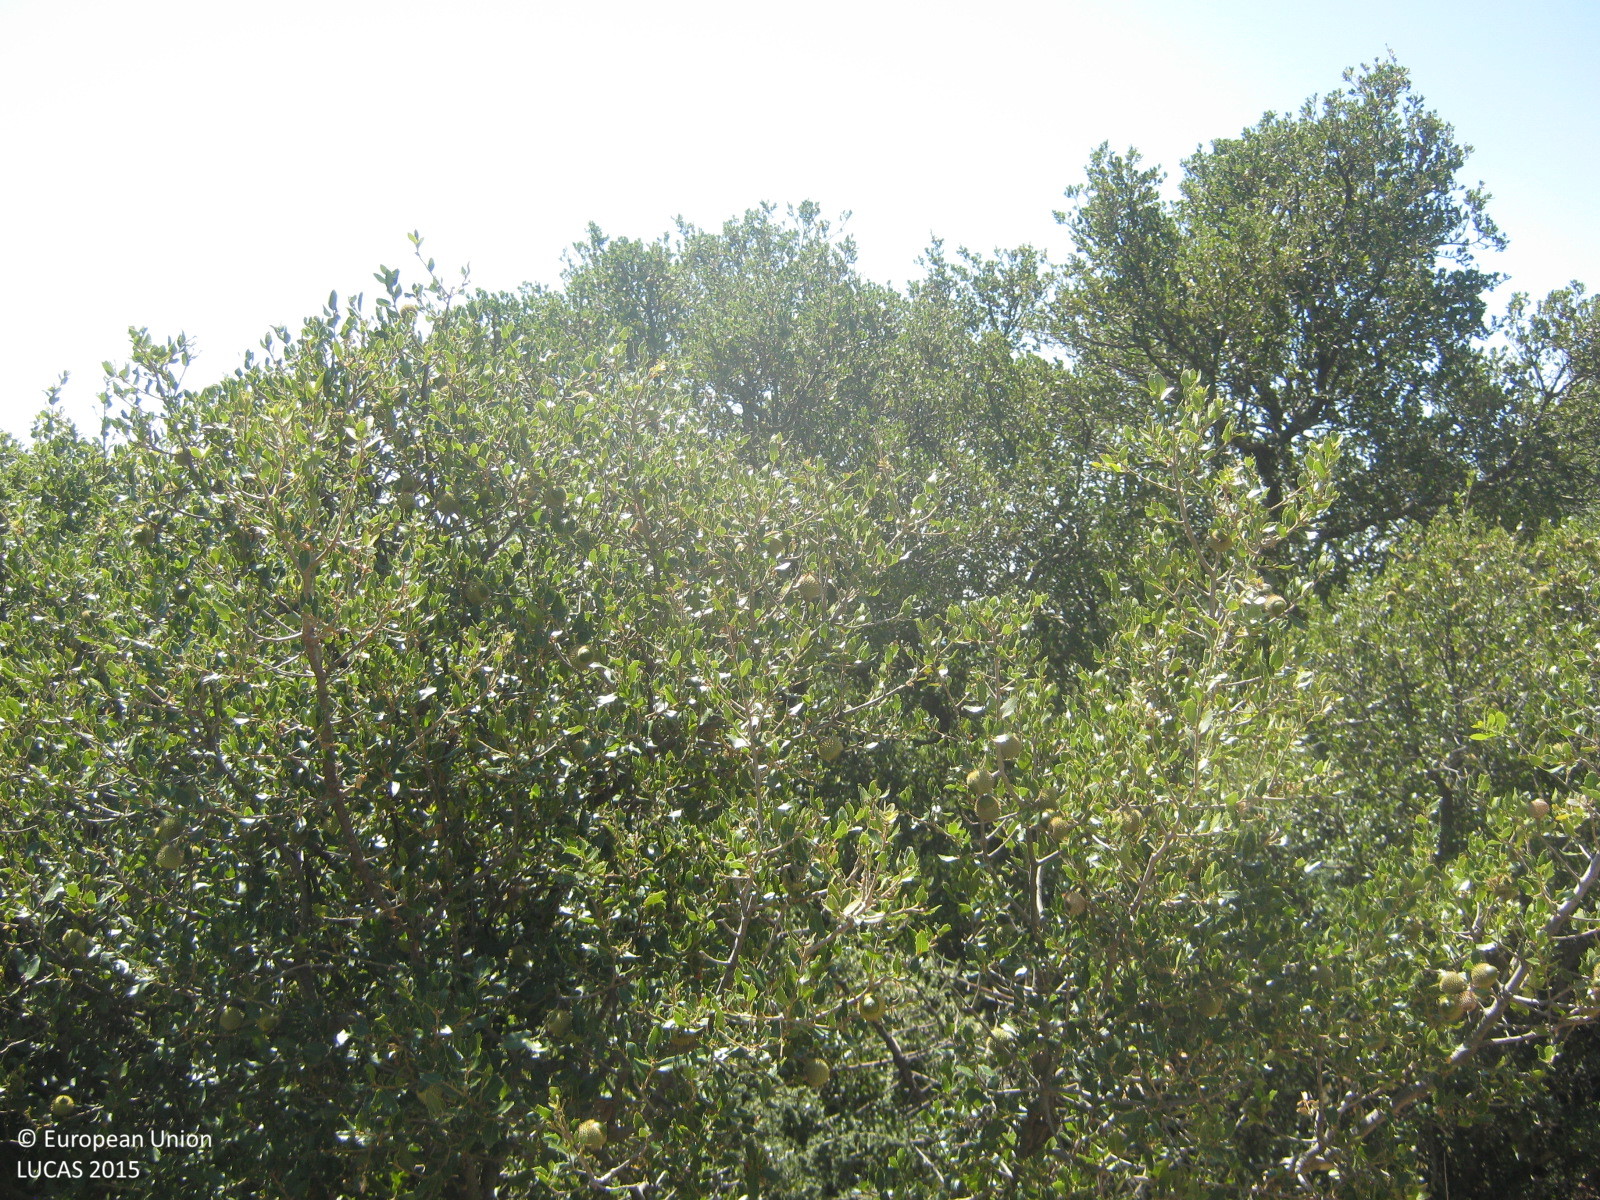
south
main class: Shrubland
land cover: Shrubland with sparse tree cover
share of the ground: > 75 %
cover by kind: shrubs 85 %, herbaceous plants 10 %, broadleaved forest trees 5 %
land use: Semi-natural and natural areas not in use
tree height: > 5 m
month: September
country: GR
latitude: 37.8406
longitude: 21.7462
